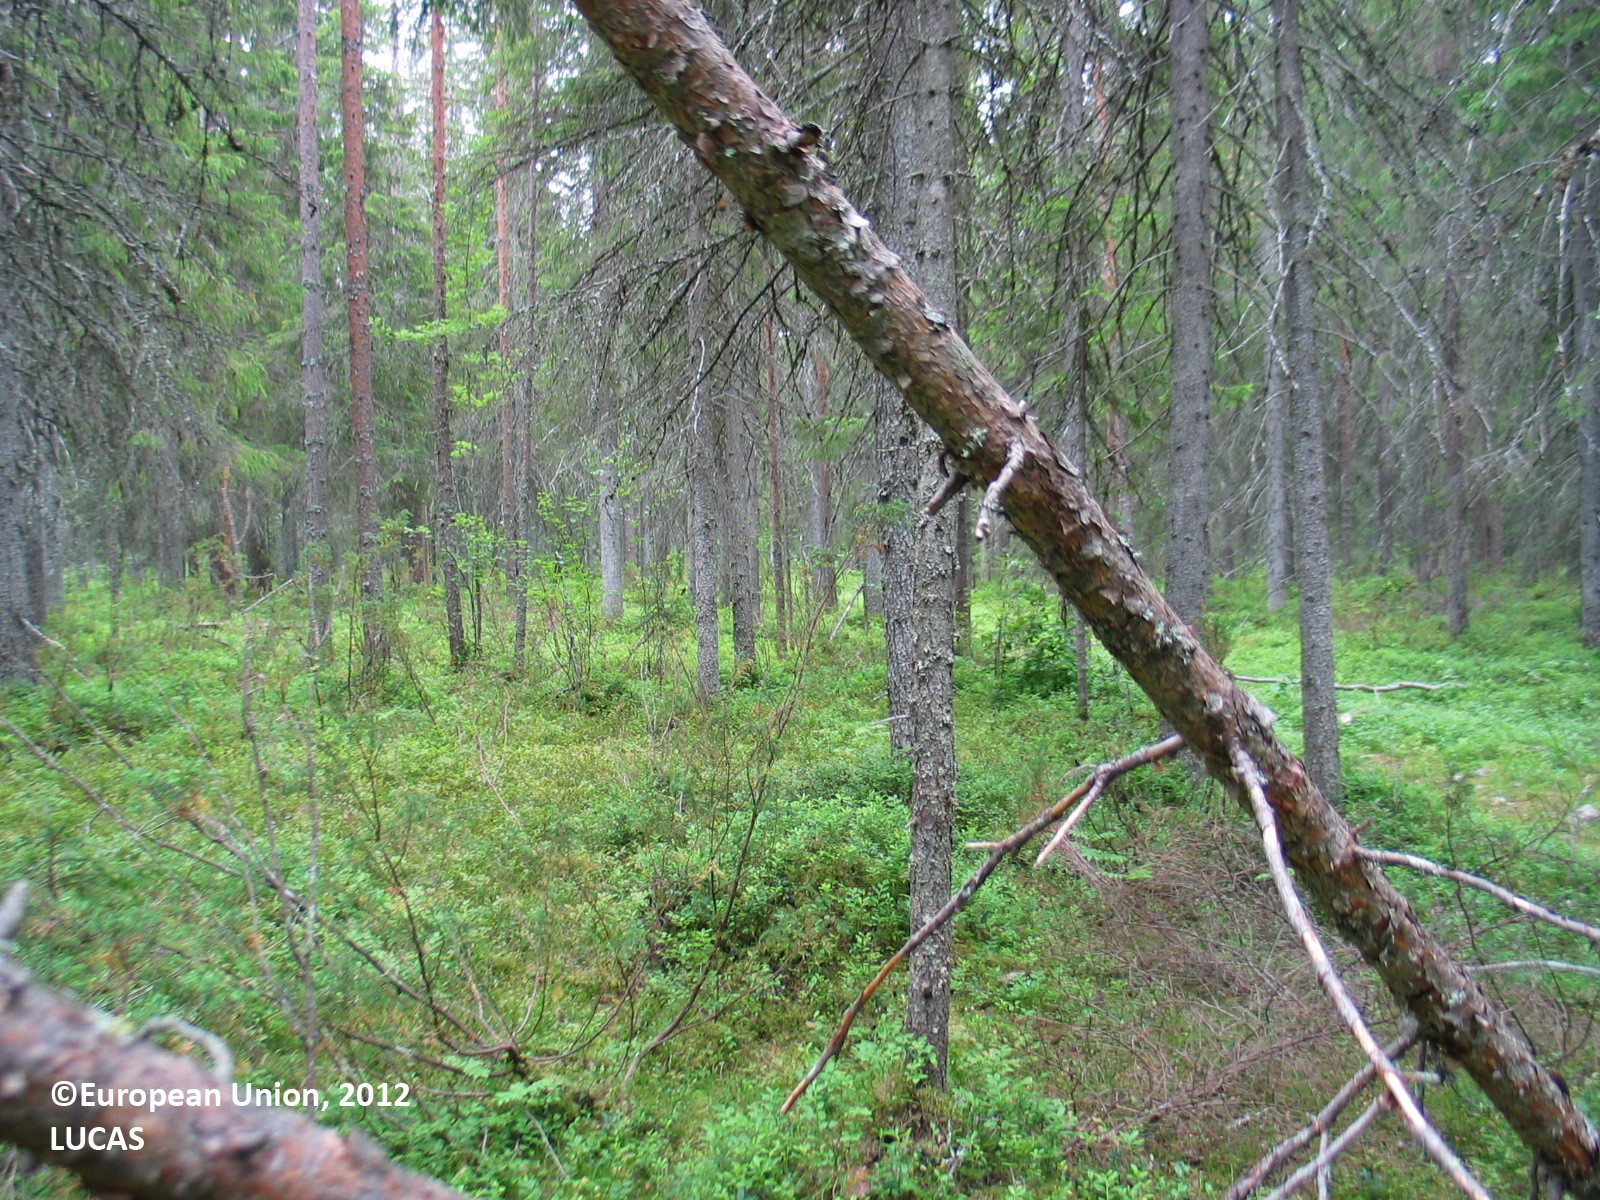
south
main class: Woodland
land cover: Spruce dominated coniferous woodland
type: boreal forest
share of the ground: 50 - 75 %
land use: Forestry
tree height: > 5 m
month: July
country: FI
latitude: 65.7633
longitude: 25.2412
